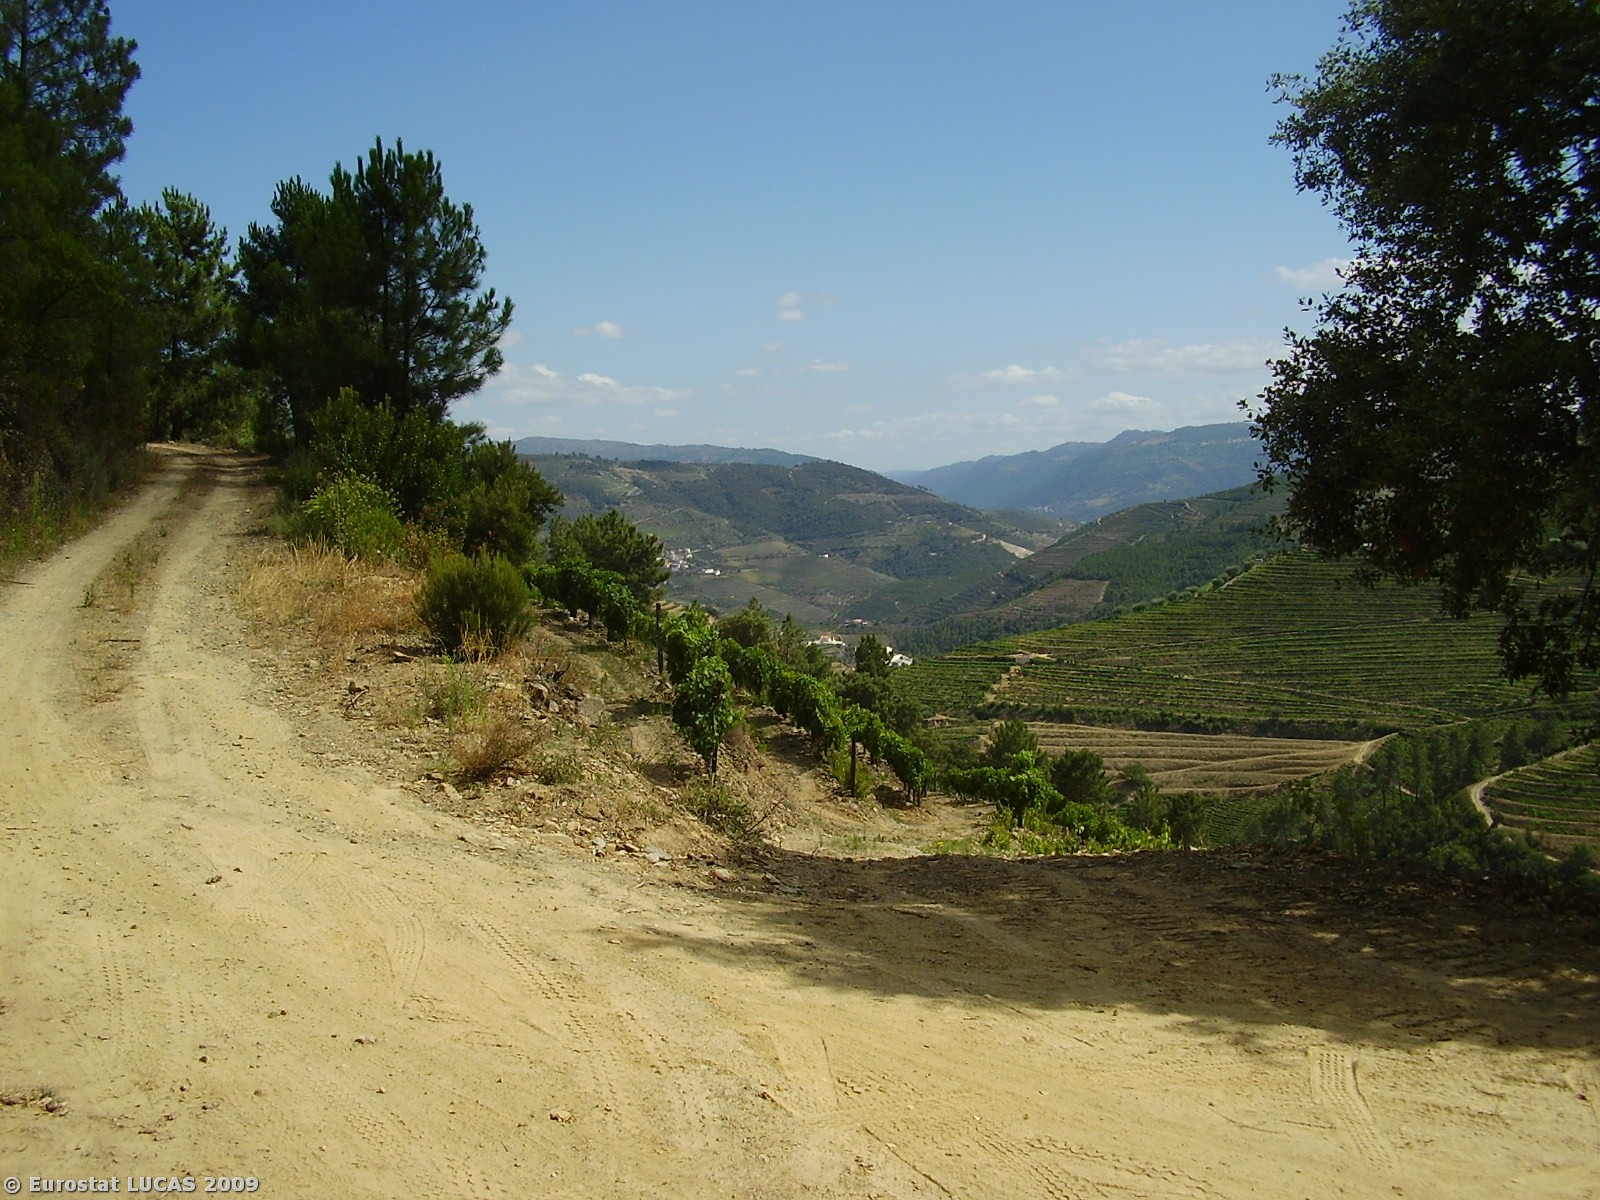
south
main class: Woodland
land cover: Broadleaved woodland
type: broadleaved evergreen forest
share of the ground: > 75 %
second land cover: Spontaneously vegetated surfaces
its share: 10 - 25 %
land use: Unused
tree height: > 5 m
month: July
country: PT
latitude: 41.2188
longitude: -7.6490
